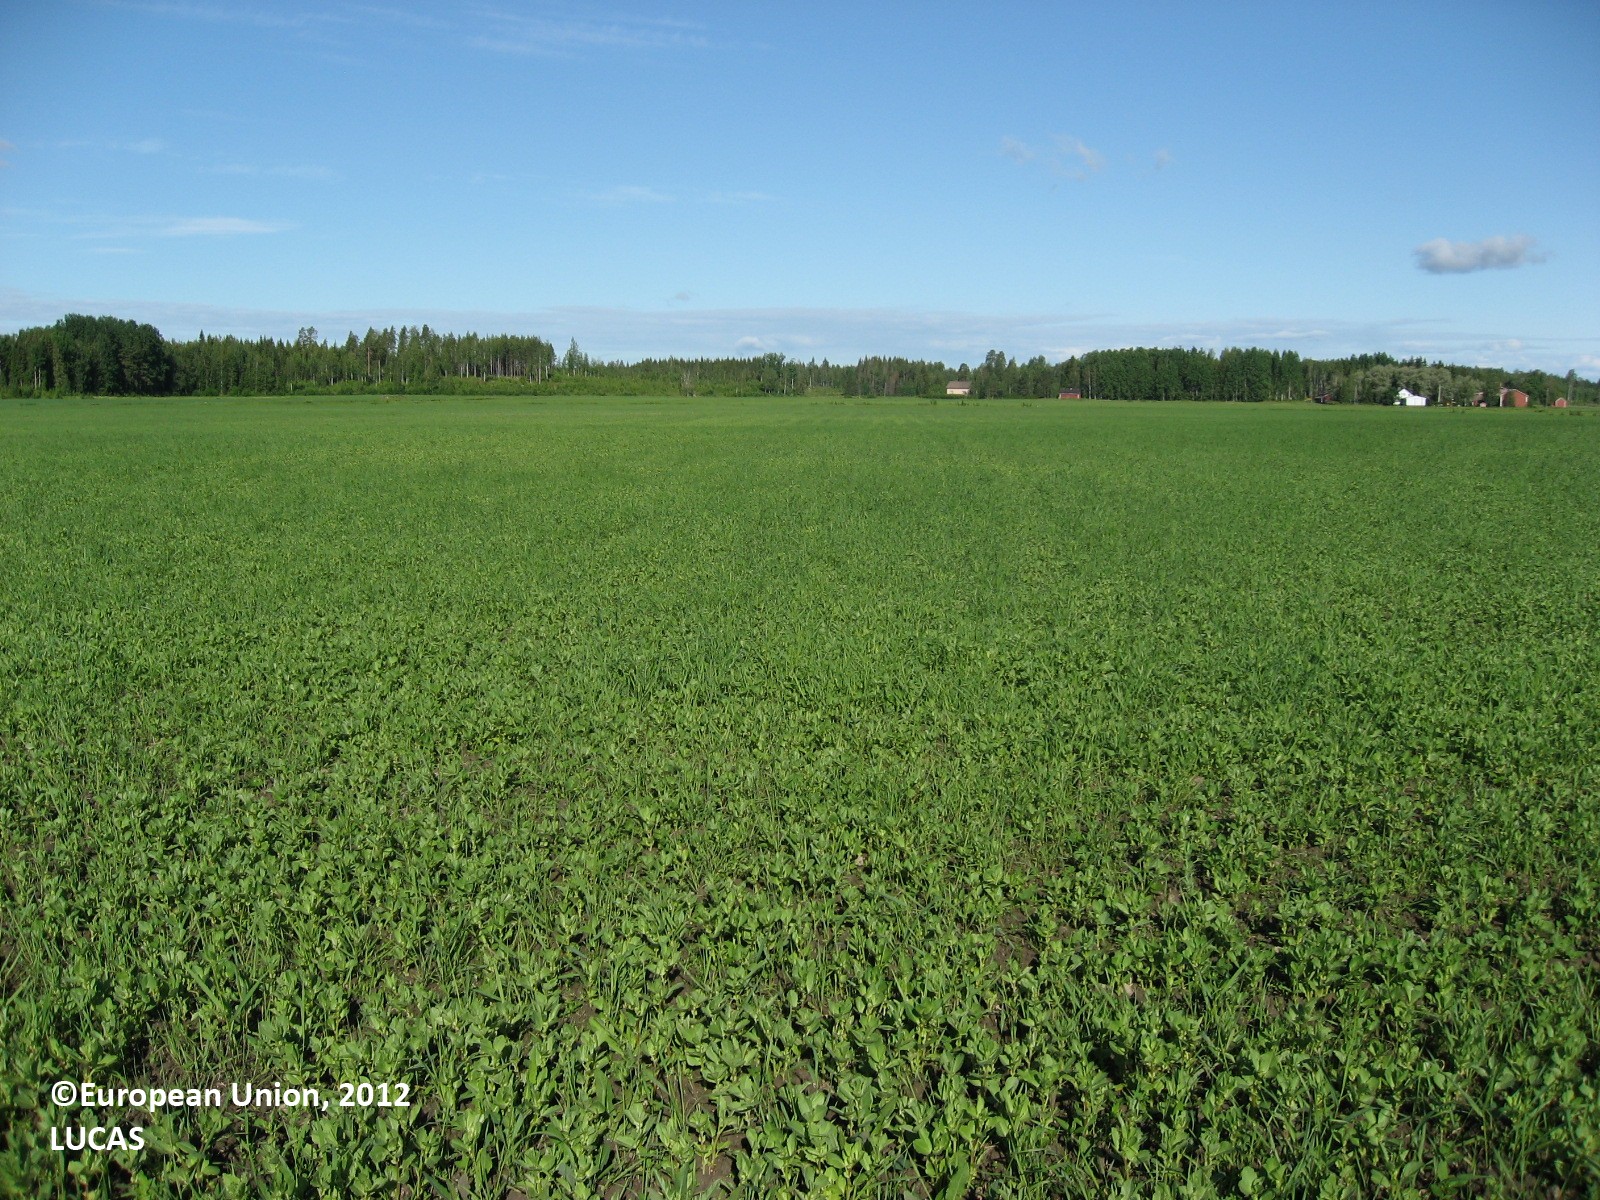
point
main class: Cropland
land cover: Dry pulses
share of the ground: 50 - 75 %
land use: Agriculture (excluding fallow land and kitchen gardens)
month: June
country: FI
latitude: 60.6528
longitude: 26.3759
